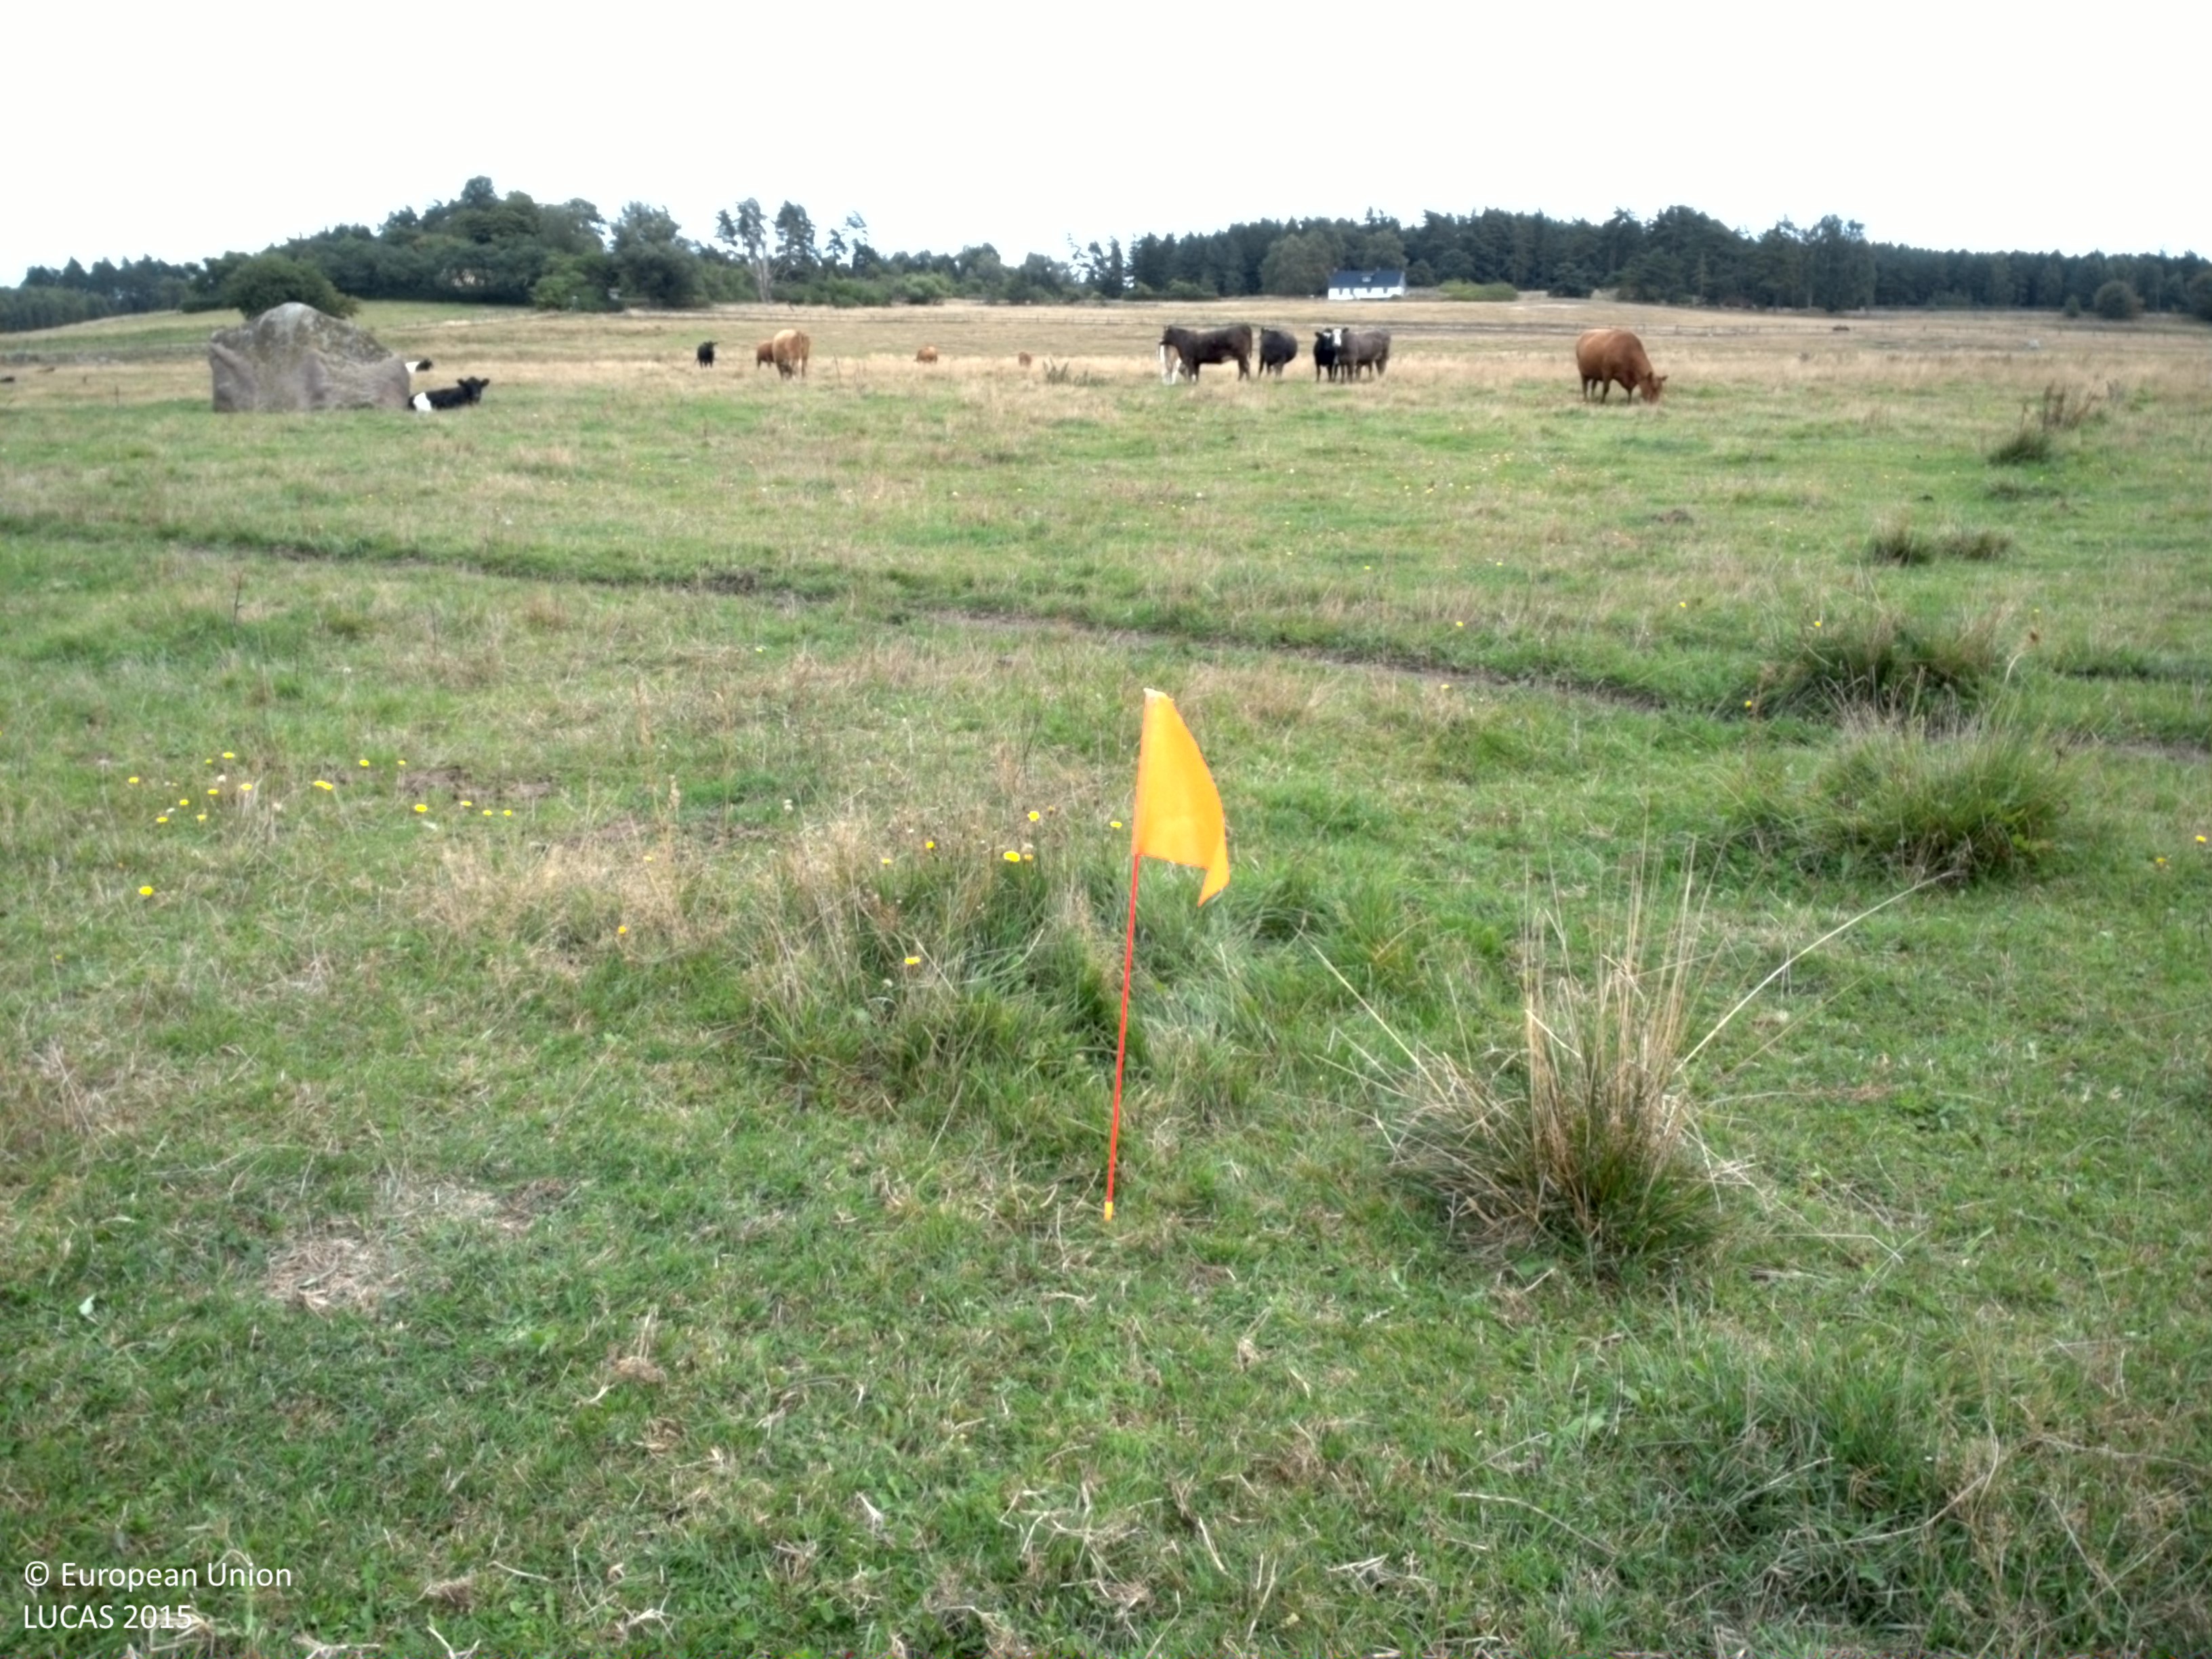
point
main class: Grassland
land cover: Grassland without tree/shrub cover
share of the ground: > 75 %
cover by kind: herbaceous plants 100 %
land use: Agriculture (excluding fallow land and kitchen gardens)
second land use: Amenities, museums, leisure
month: September
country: SE
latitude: 55.5598
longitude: 13.6607
